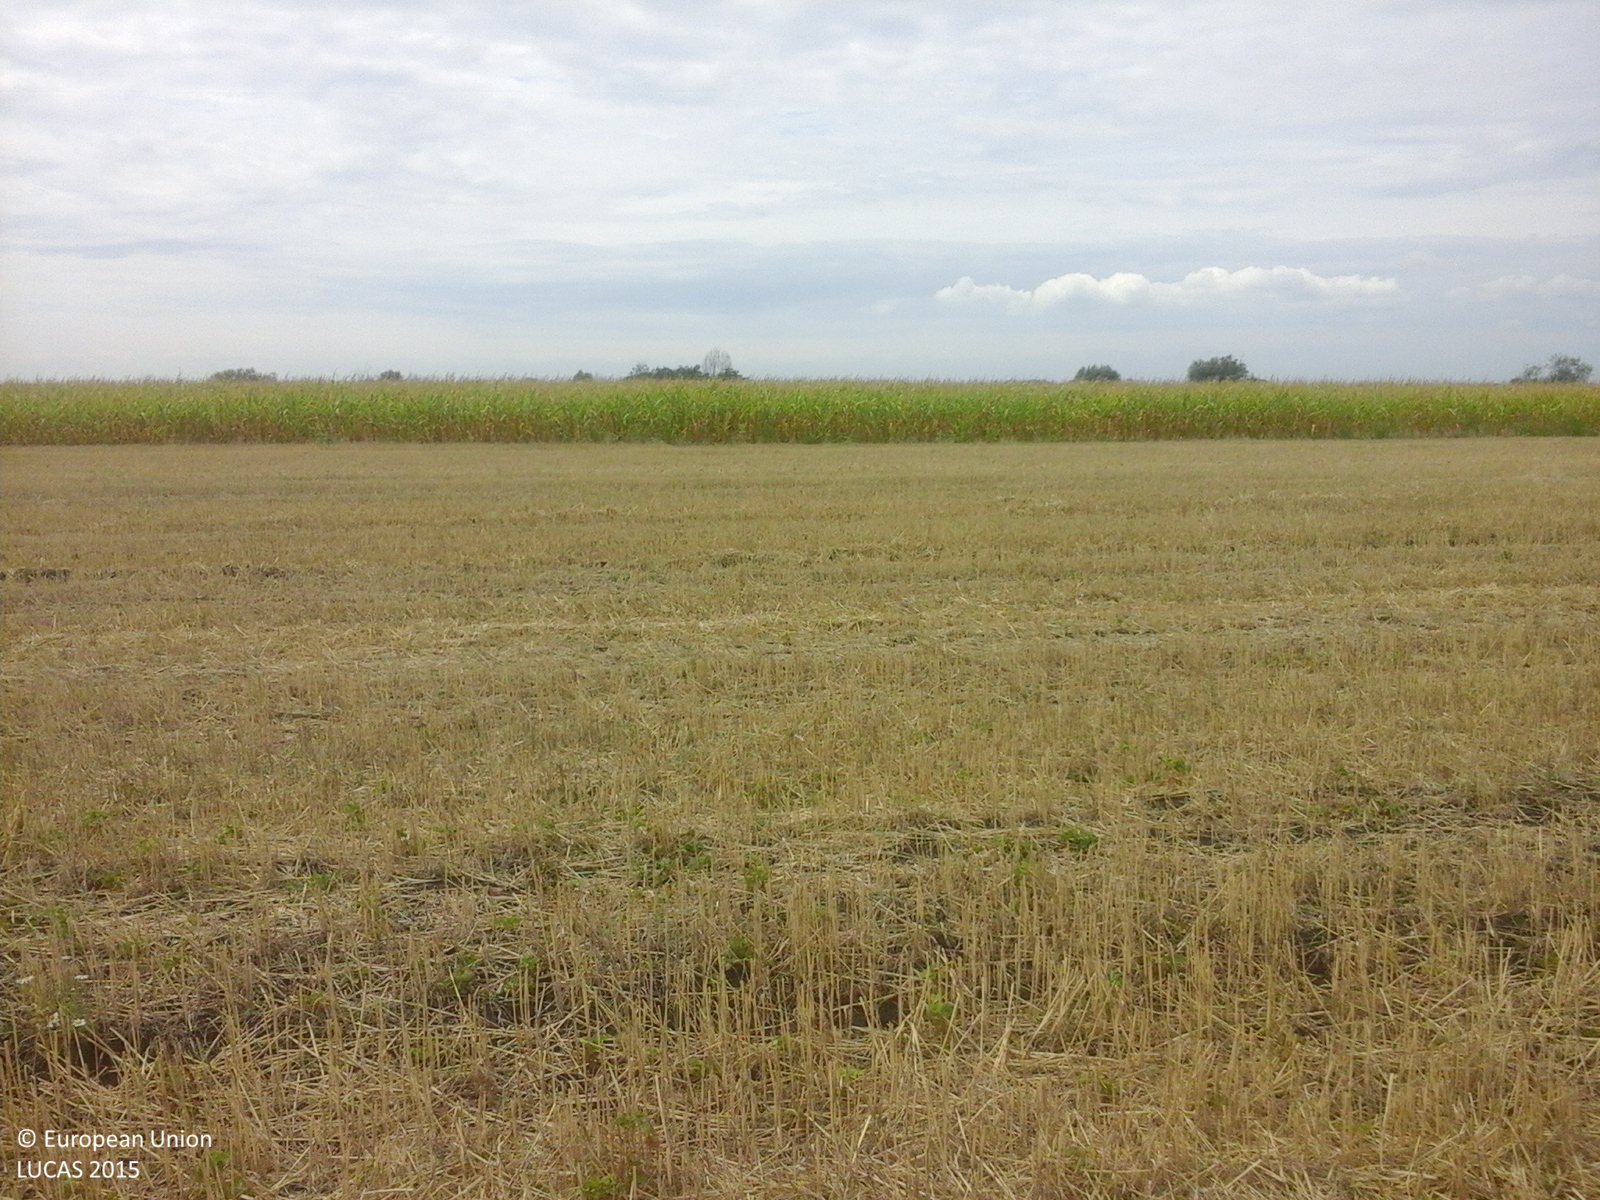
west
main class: Cropland
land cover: Maize
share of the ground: > 75 %
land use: Agriculture (excluding fallow land and kitchen gardens)
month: August
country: RO
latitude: 45.4776
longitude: 21.3001
